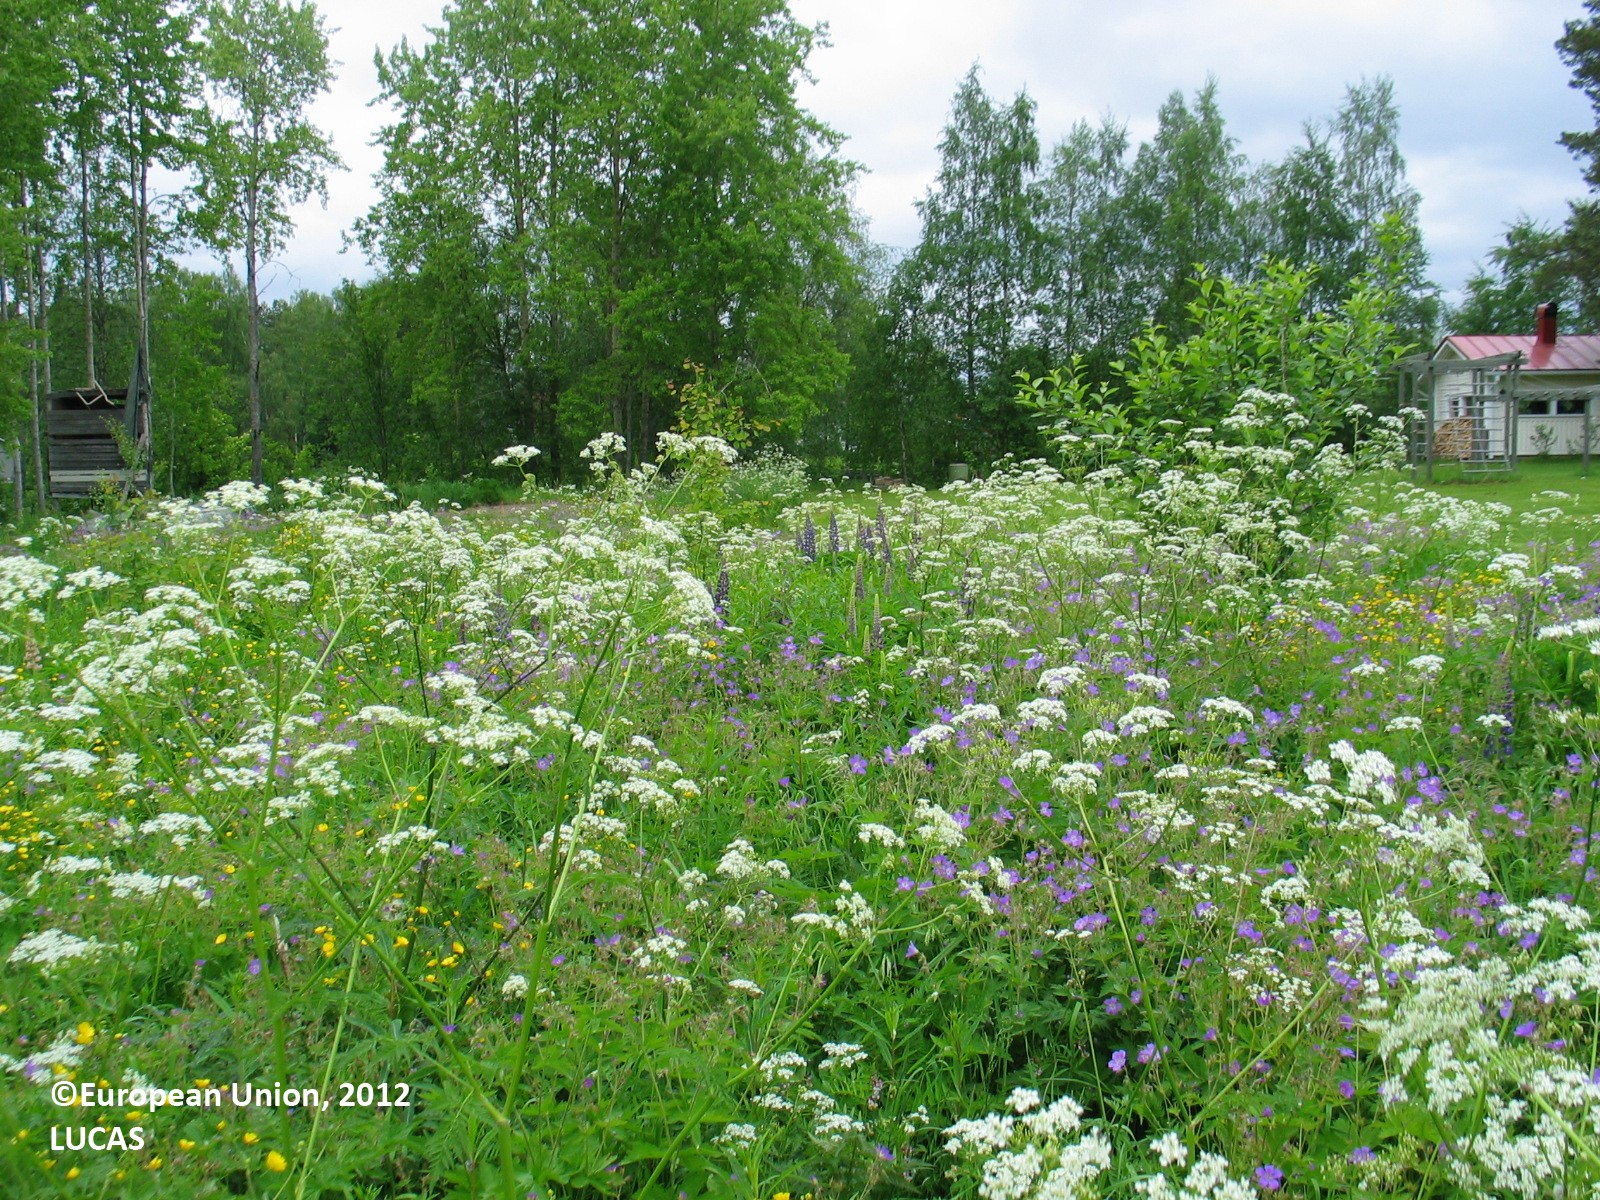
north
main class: Grassland
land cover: Grassland without tree/shrub cover
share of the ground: > 75 %
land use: Residential
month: June
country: FI
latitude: 65.1935
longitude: 25.3951
